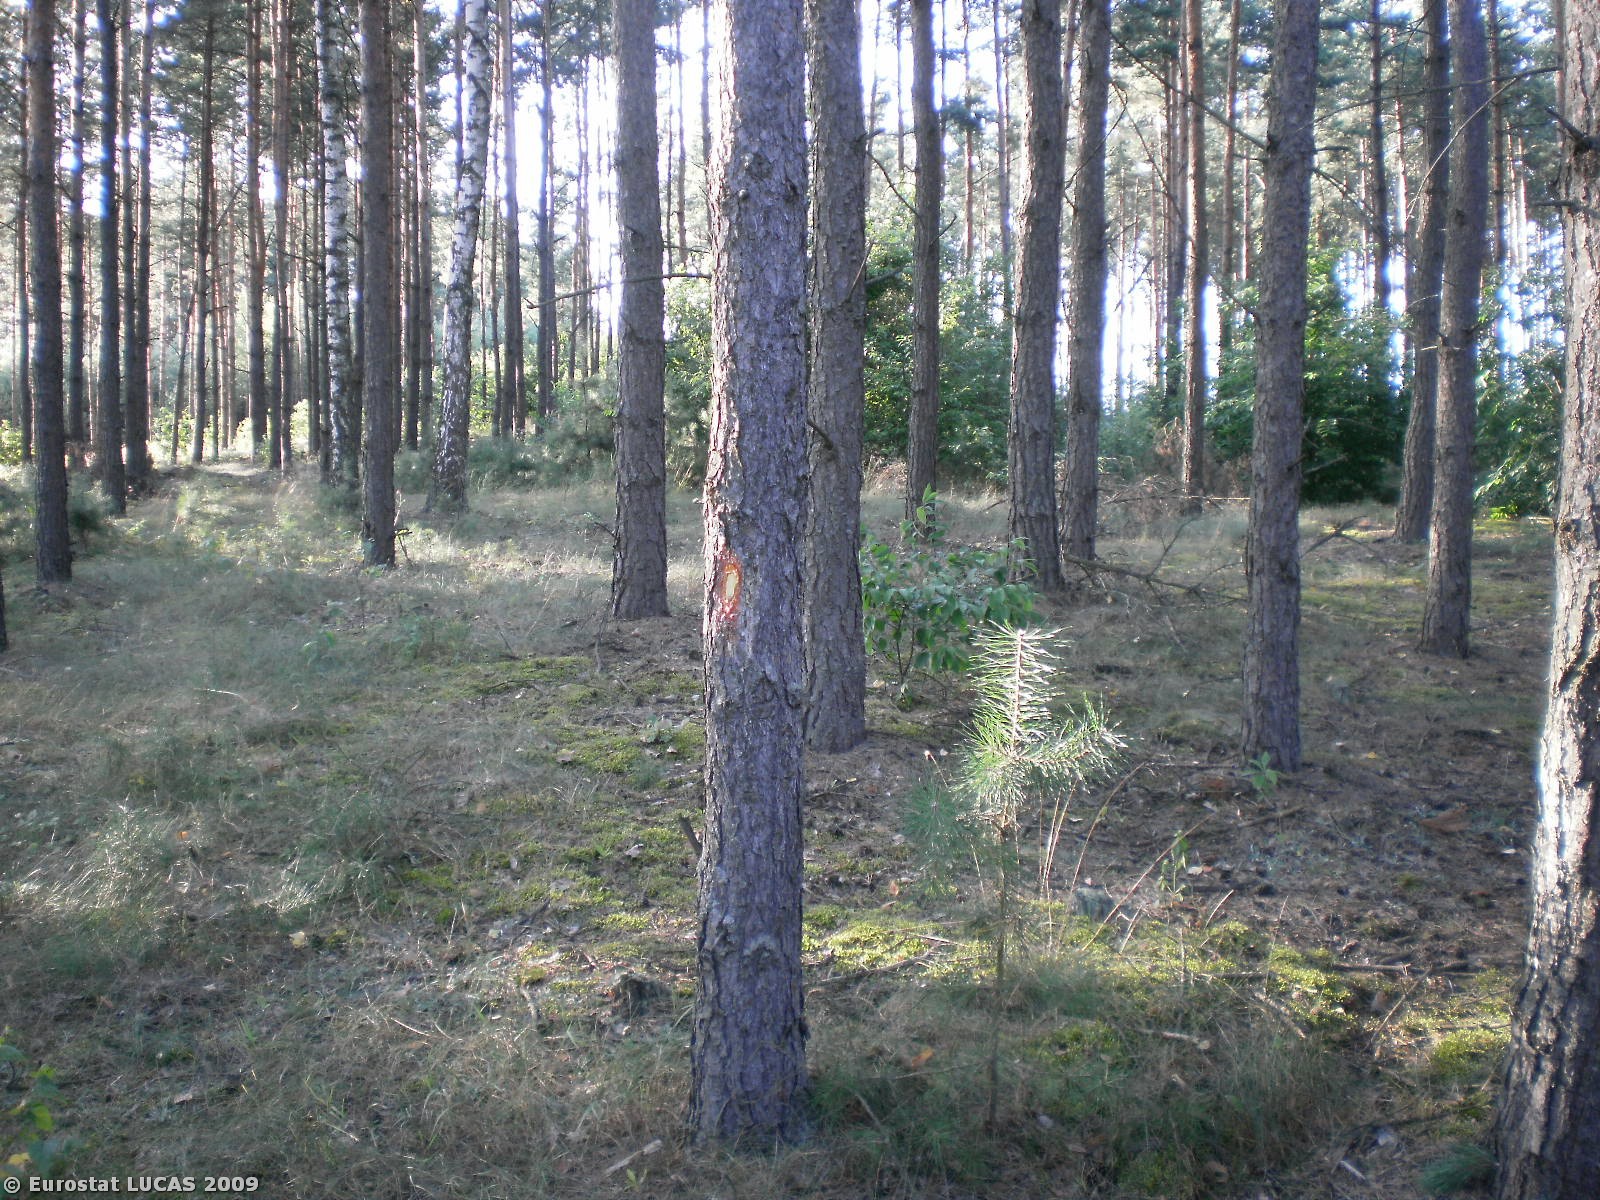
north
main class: Woodland
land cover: Coniferous woodland
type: hemiboreal forest and nemoral coniferous forest and mixed broadleaved-coniferous forest
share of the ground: > 75 %
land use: Forestry
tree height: > 5 m
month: August
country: PL
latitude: 53.1228
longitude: 20.9364
